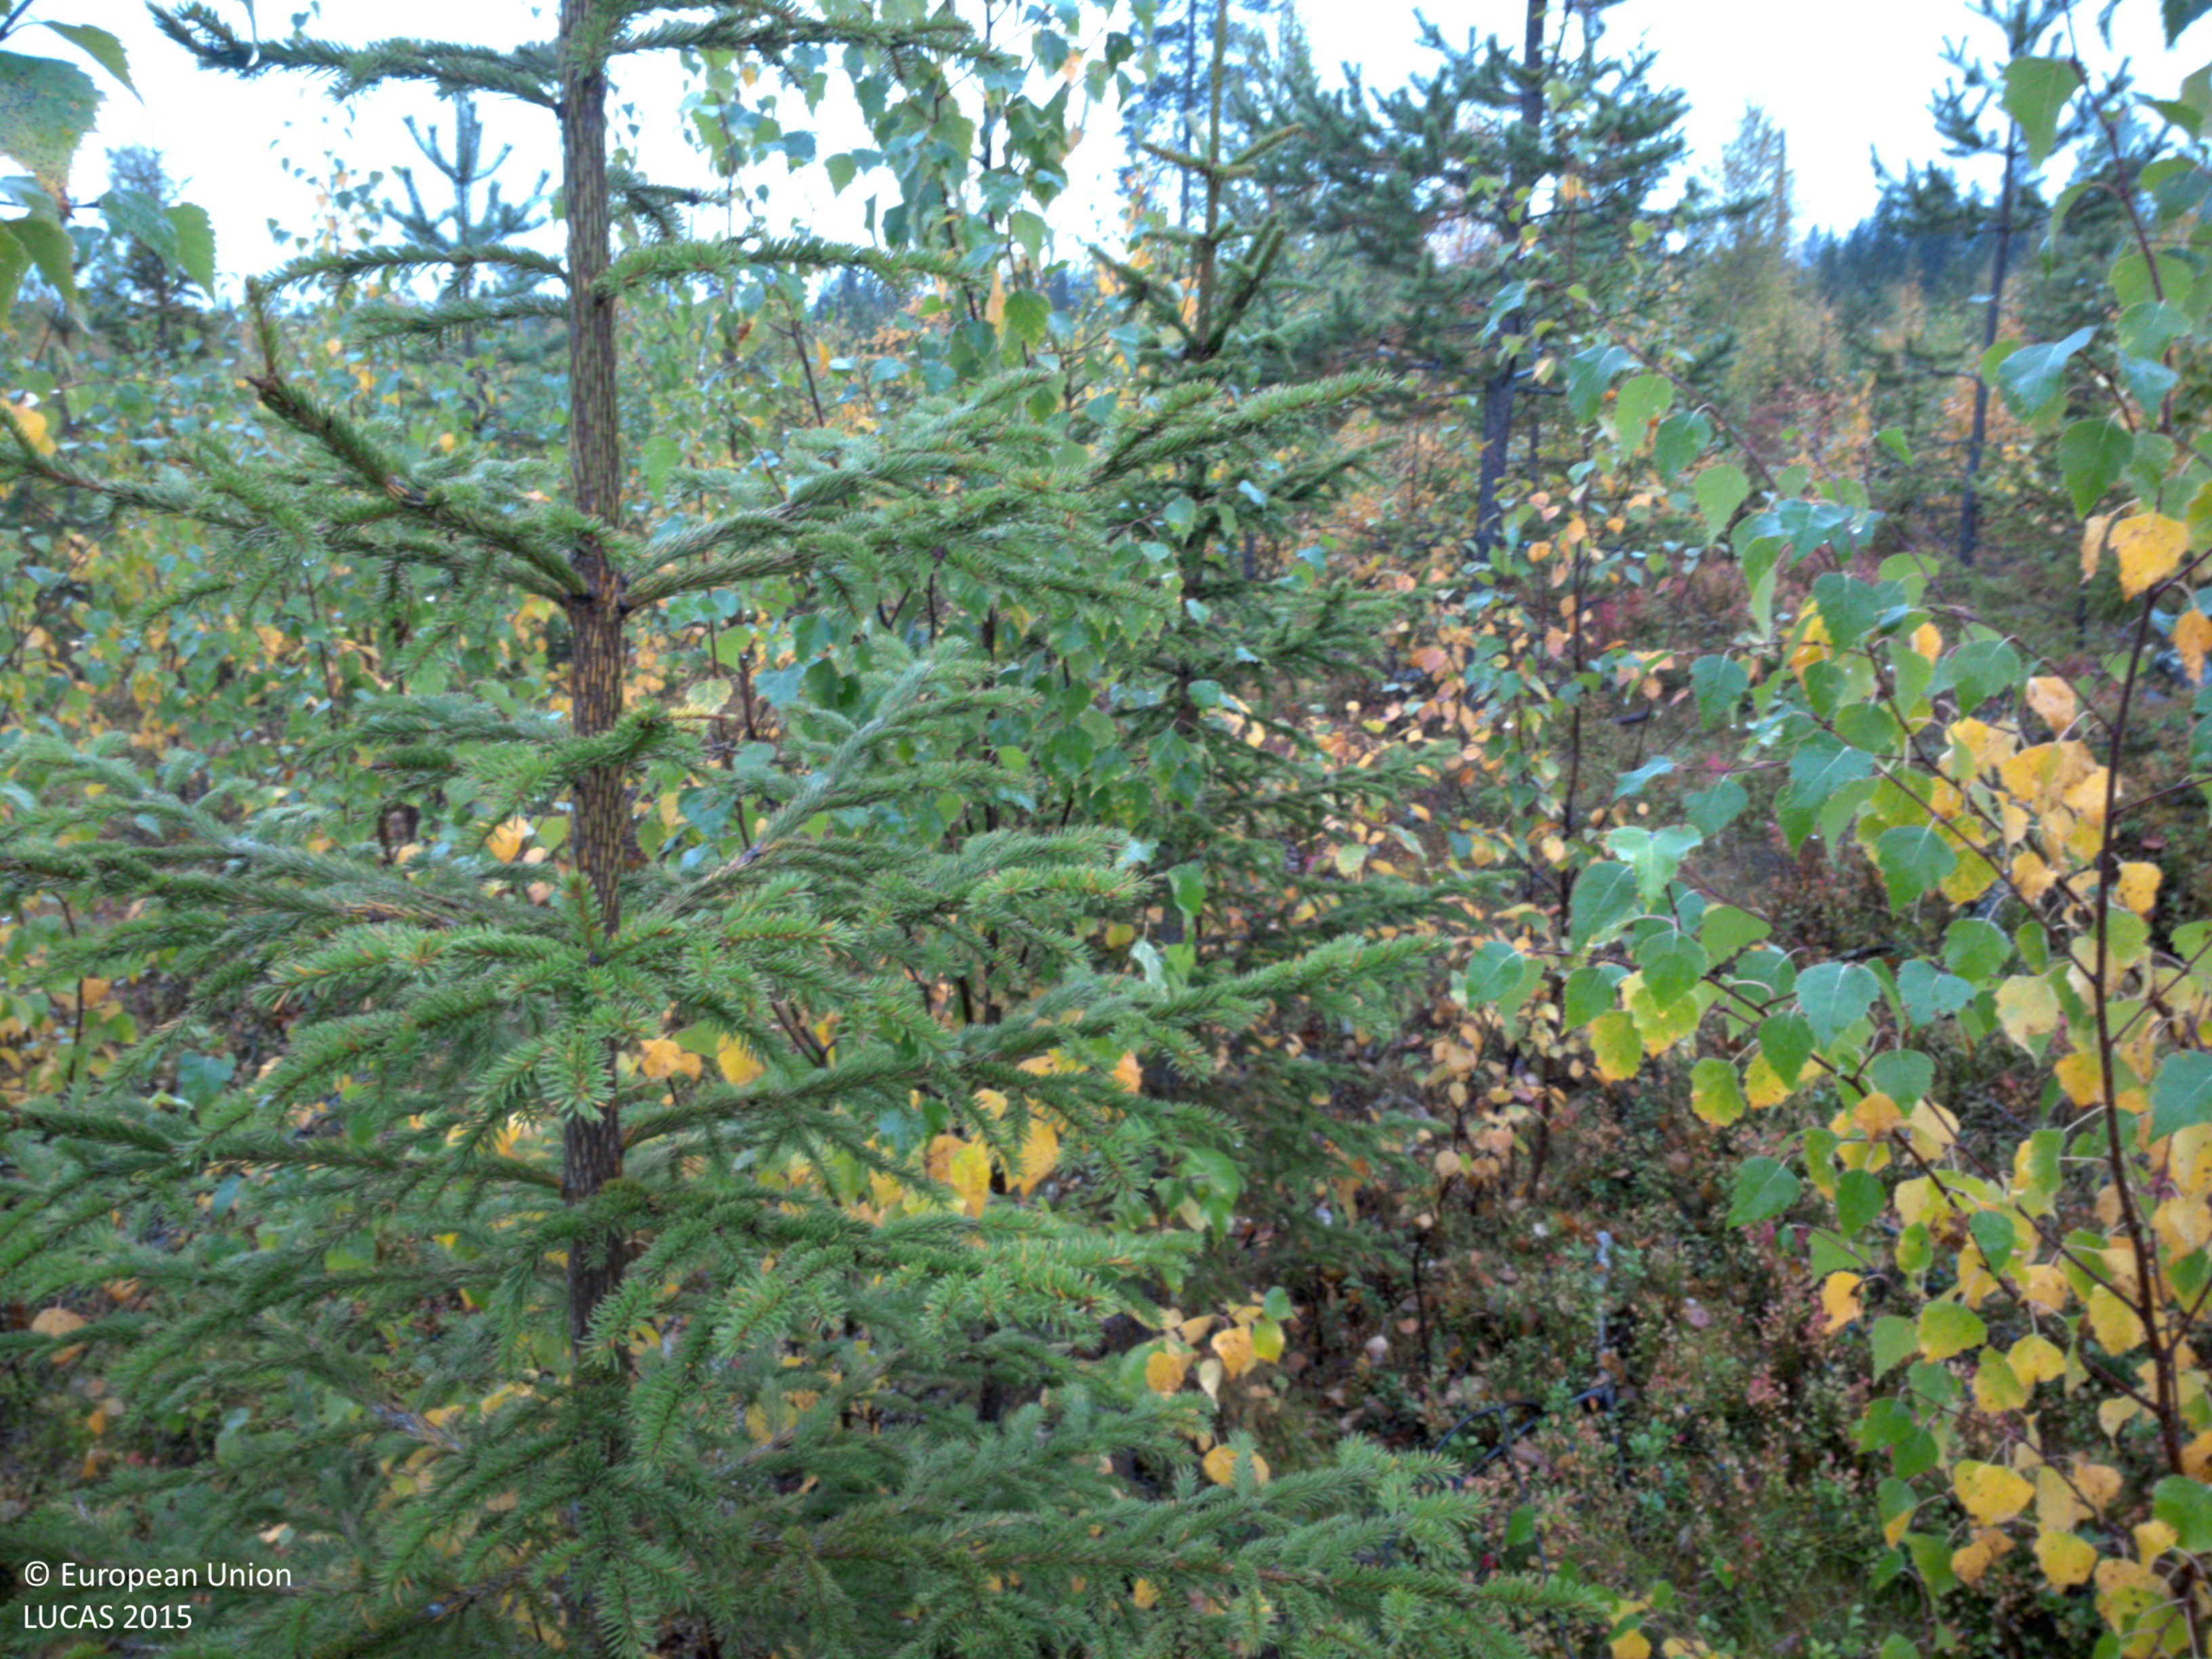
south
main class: Woodland
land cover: Spruce dominated mixed woodland
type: boreal forest
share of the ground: 50 - 75 %
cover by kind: coniferous forest trees 40 %, broadleaved forest trees 30 %, shrubs 25 %, herbaceous plants 5 %
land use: Forestry
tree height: < 5 m
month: September
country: SE
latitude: 64.9134
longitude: 19.2042
